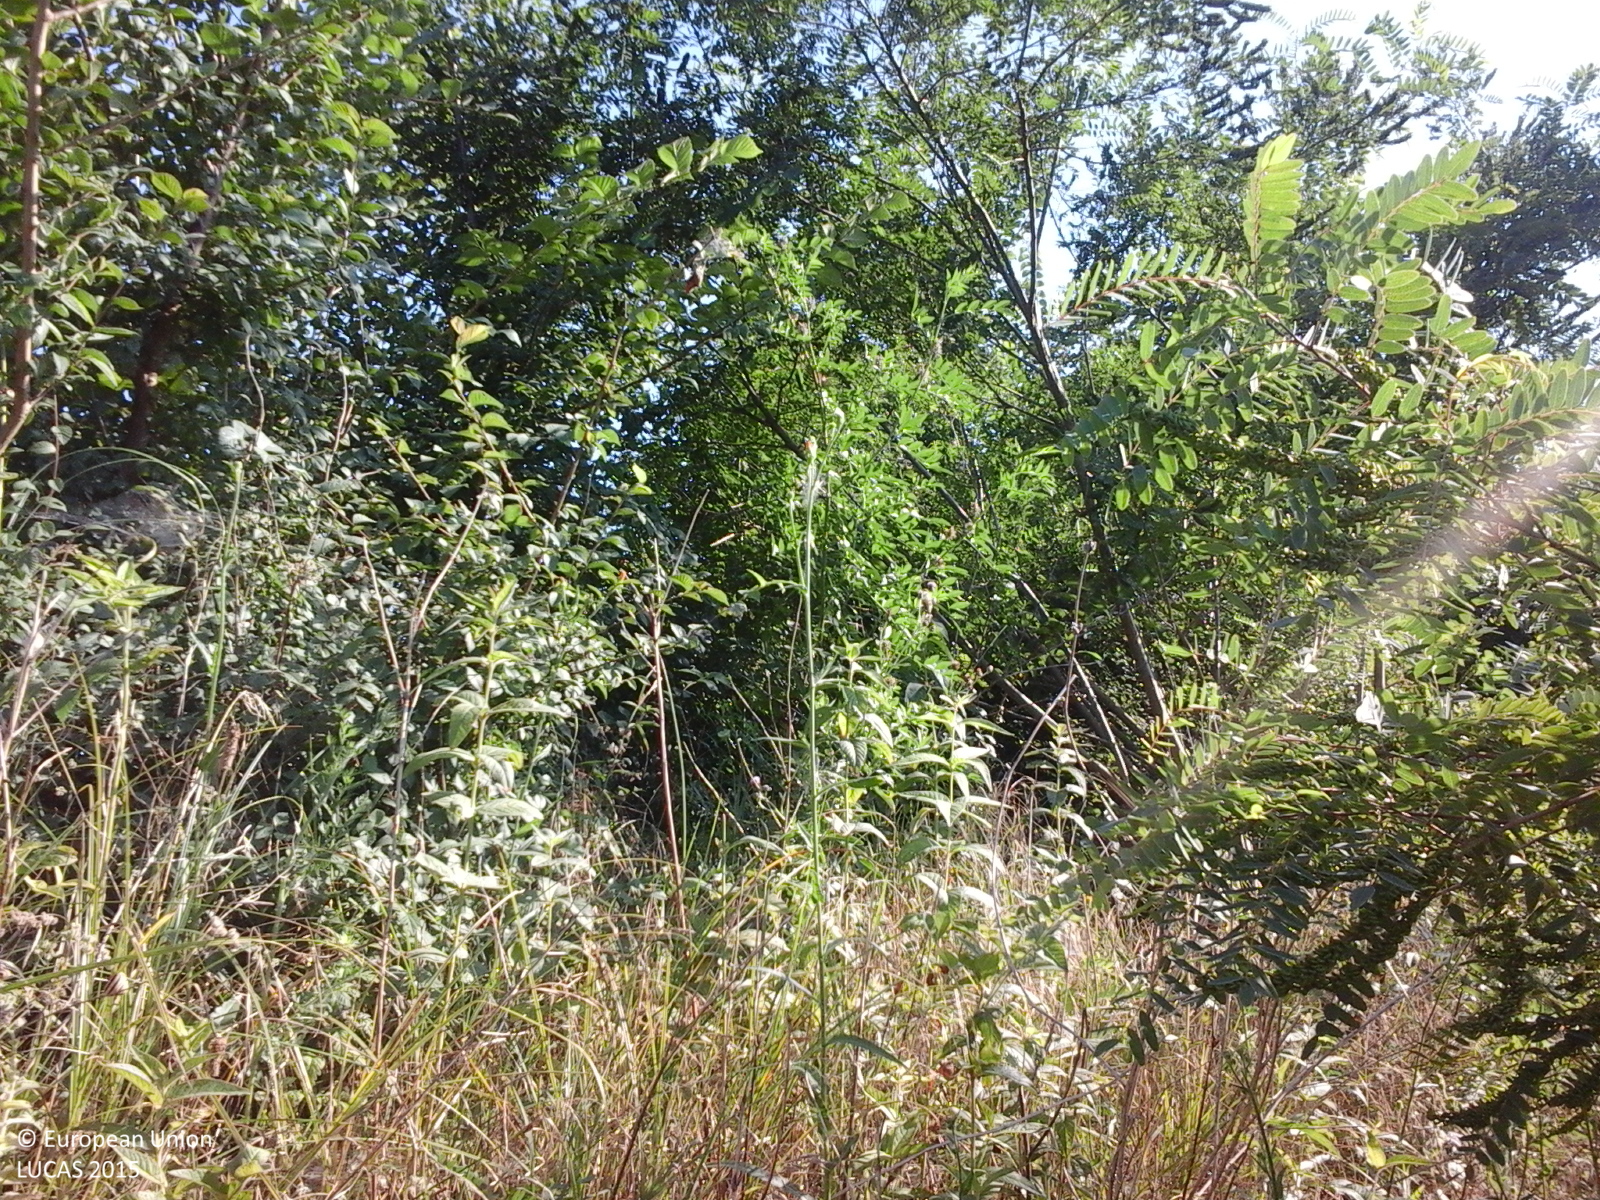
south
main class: Grassland
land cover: Spontaneously vegetated surfaces
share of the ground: > 75 %
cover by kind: herbaceous plants 100 %
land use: Semi-natural and natural areas not in use
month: July
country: RO
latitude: 44.3186
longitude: 27.7389
